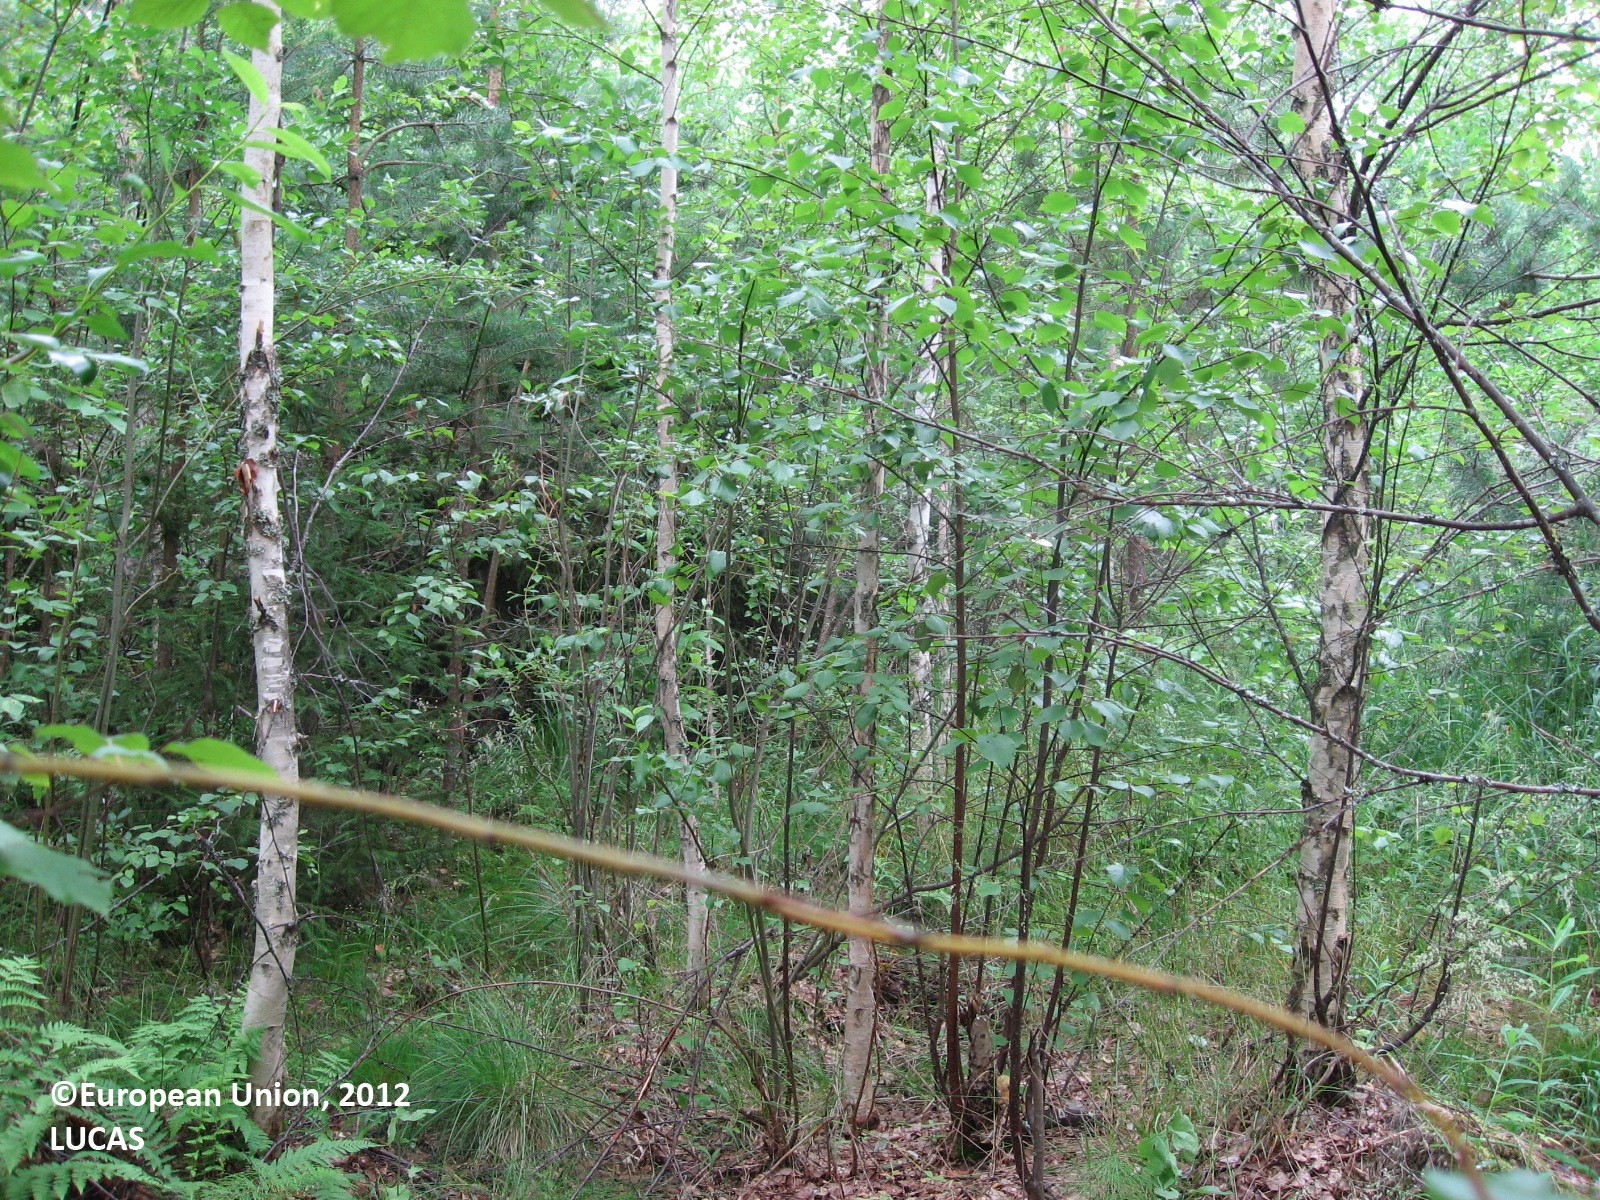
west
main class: Woodland
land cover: Spruce dominated mixed woodland
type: boreal forest
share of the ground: > 75 %
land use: Forestry
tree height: > 5 m
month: July
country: FI
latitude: 60.8465
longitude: 25.6432
